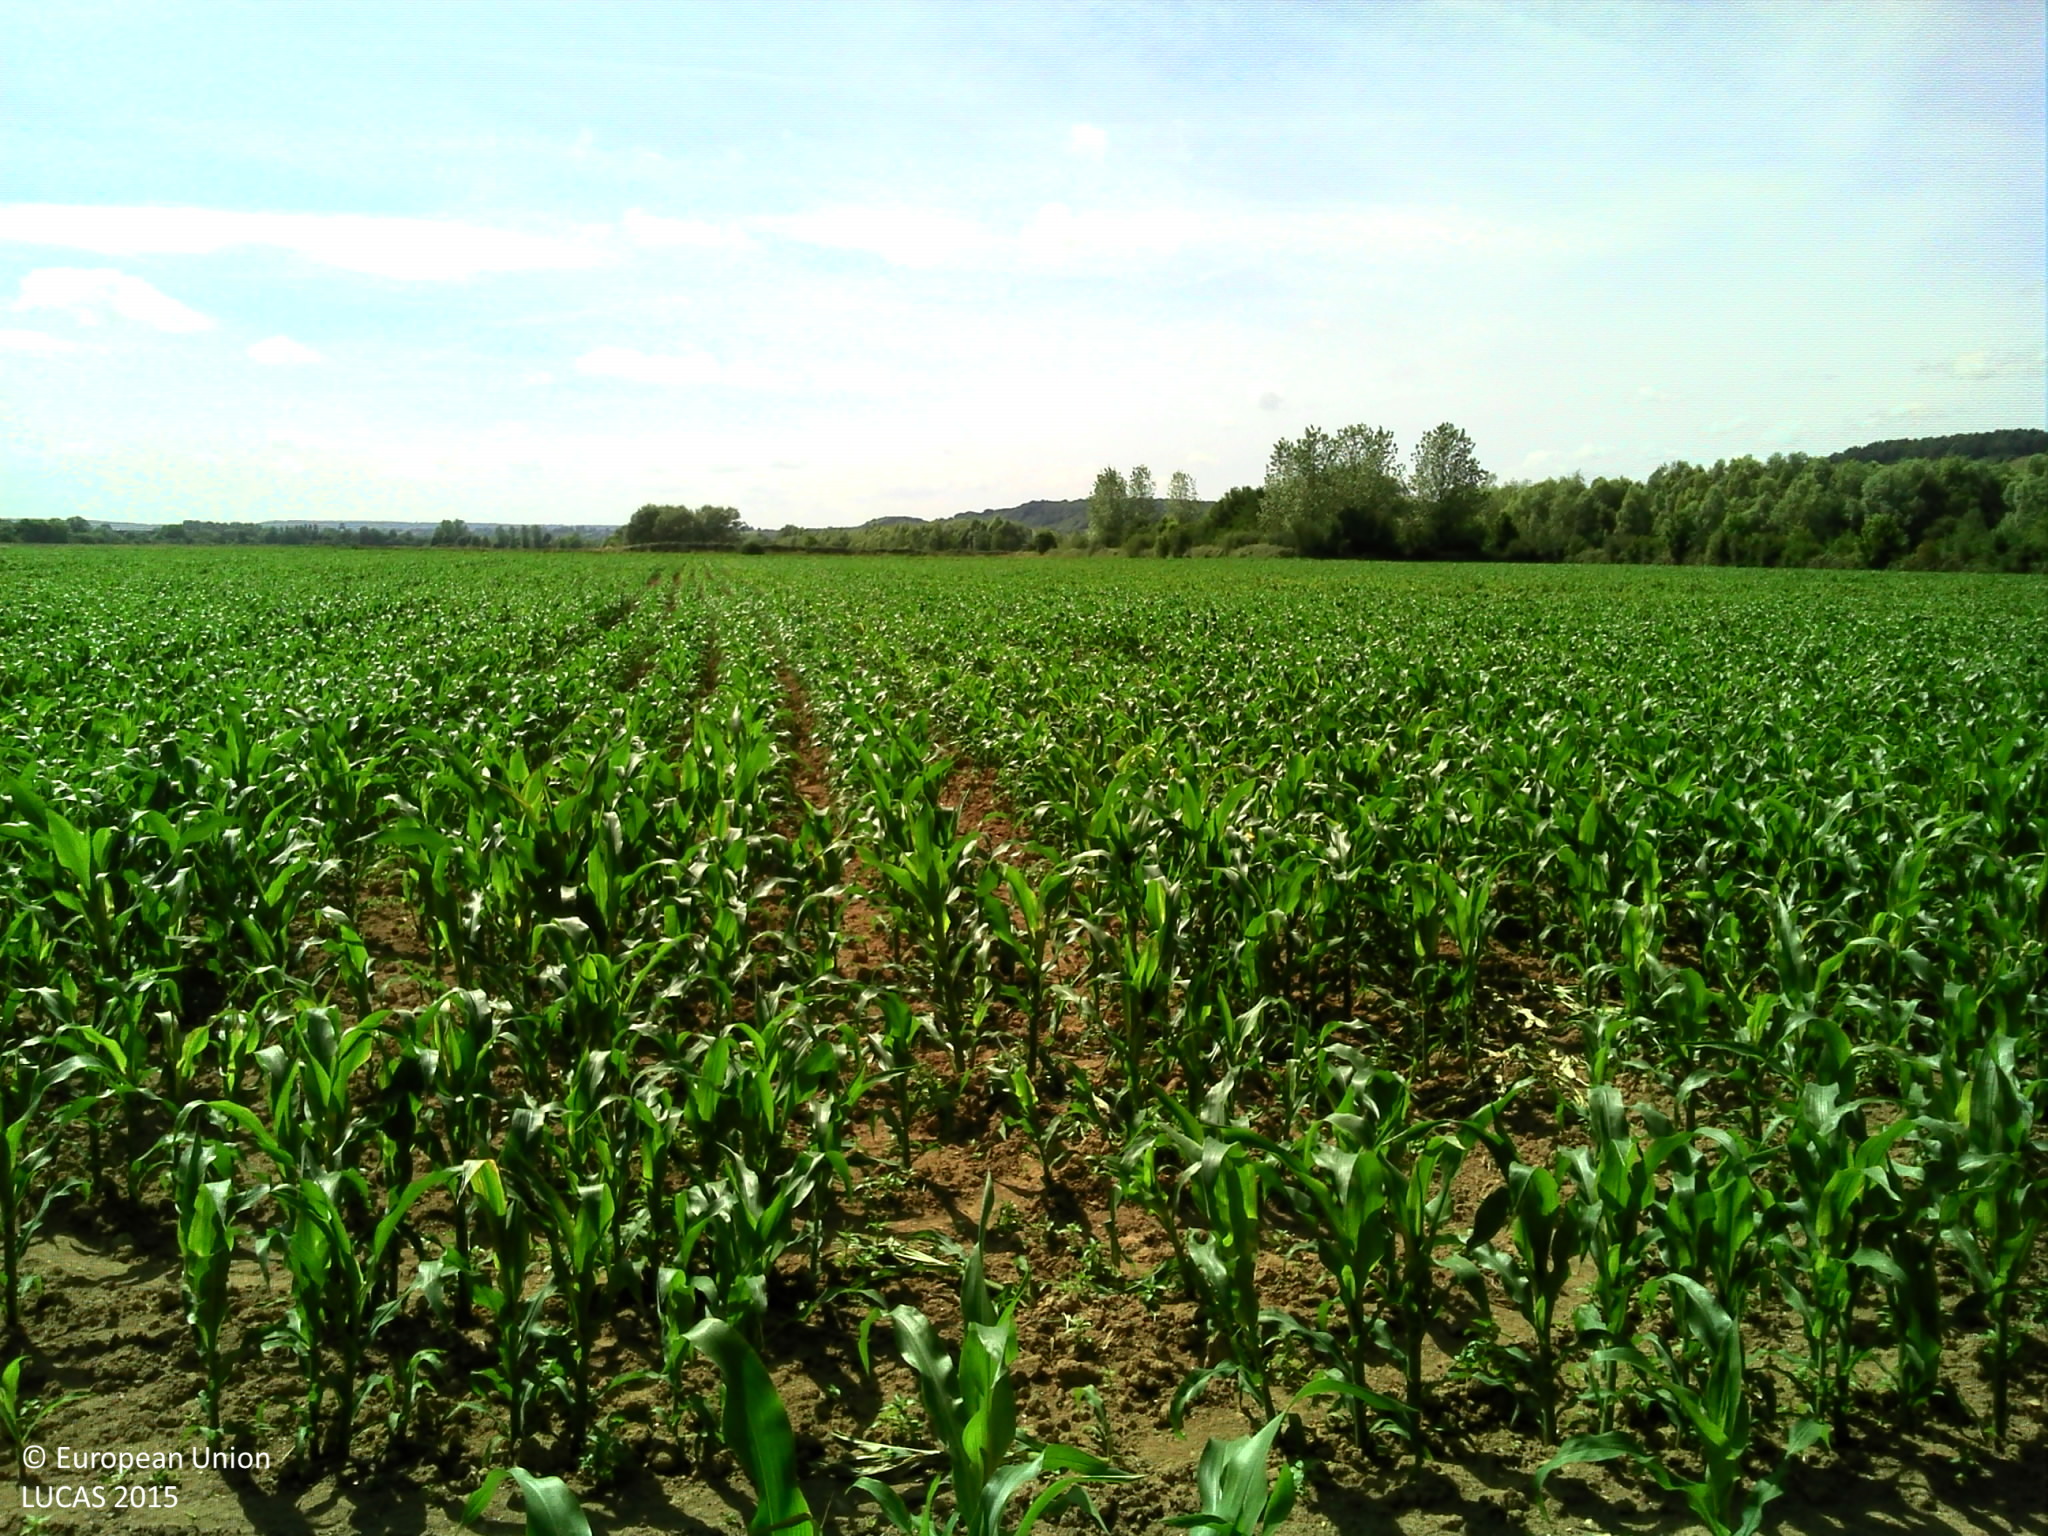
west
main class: Cropland
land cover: Maize
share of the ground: 25 - 50 %
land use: Agriculture (excluding fallow land and kitchen gardens)
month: June
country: FR
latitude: 49.3136
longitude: 1.1341
